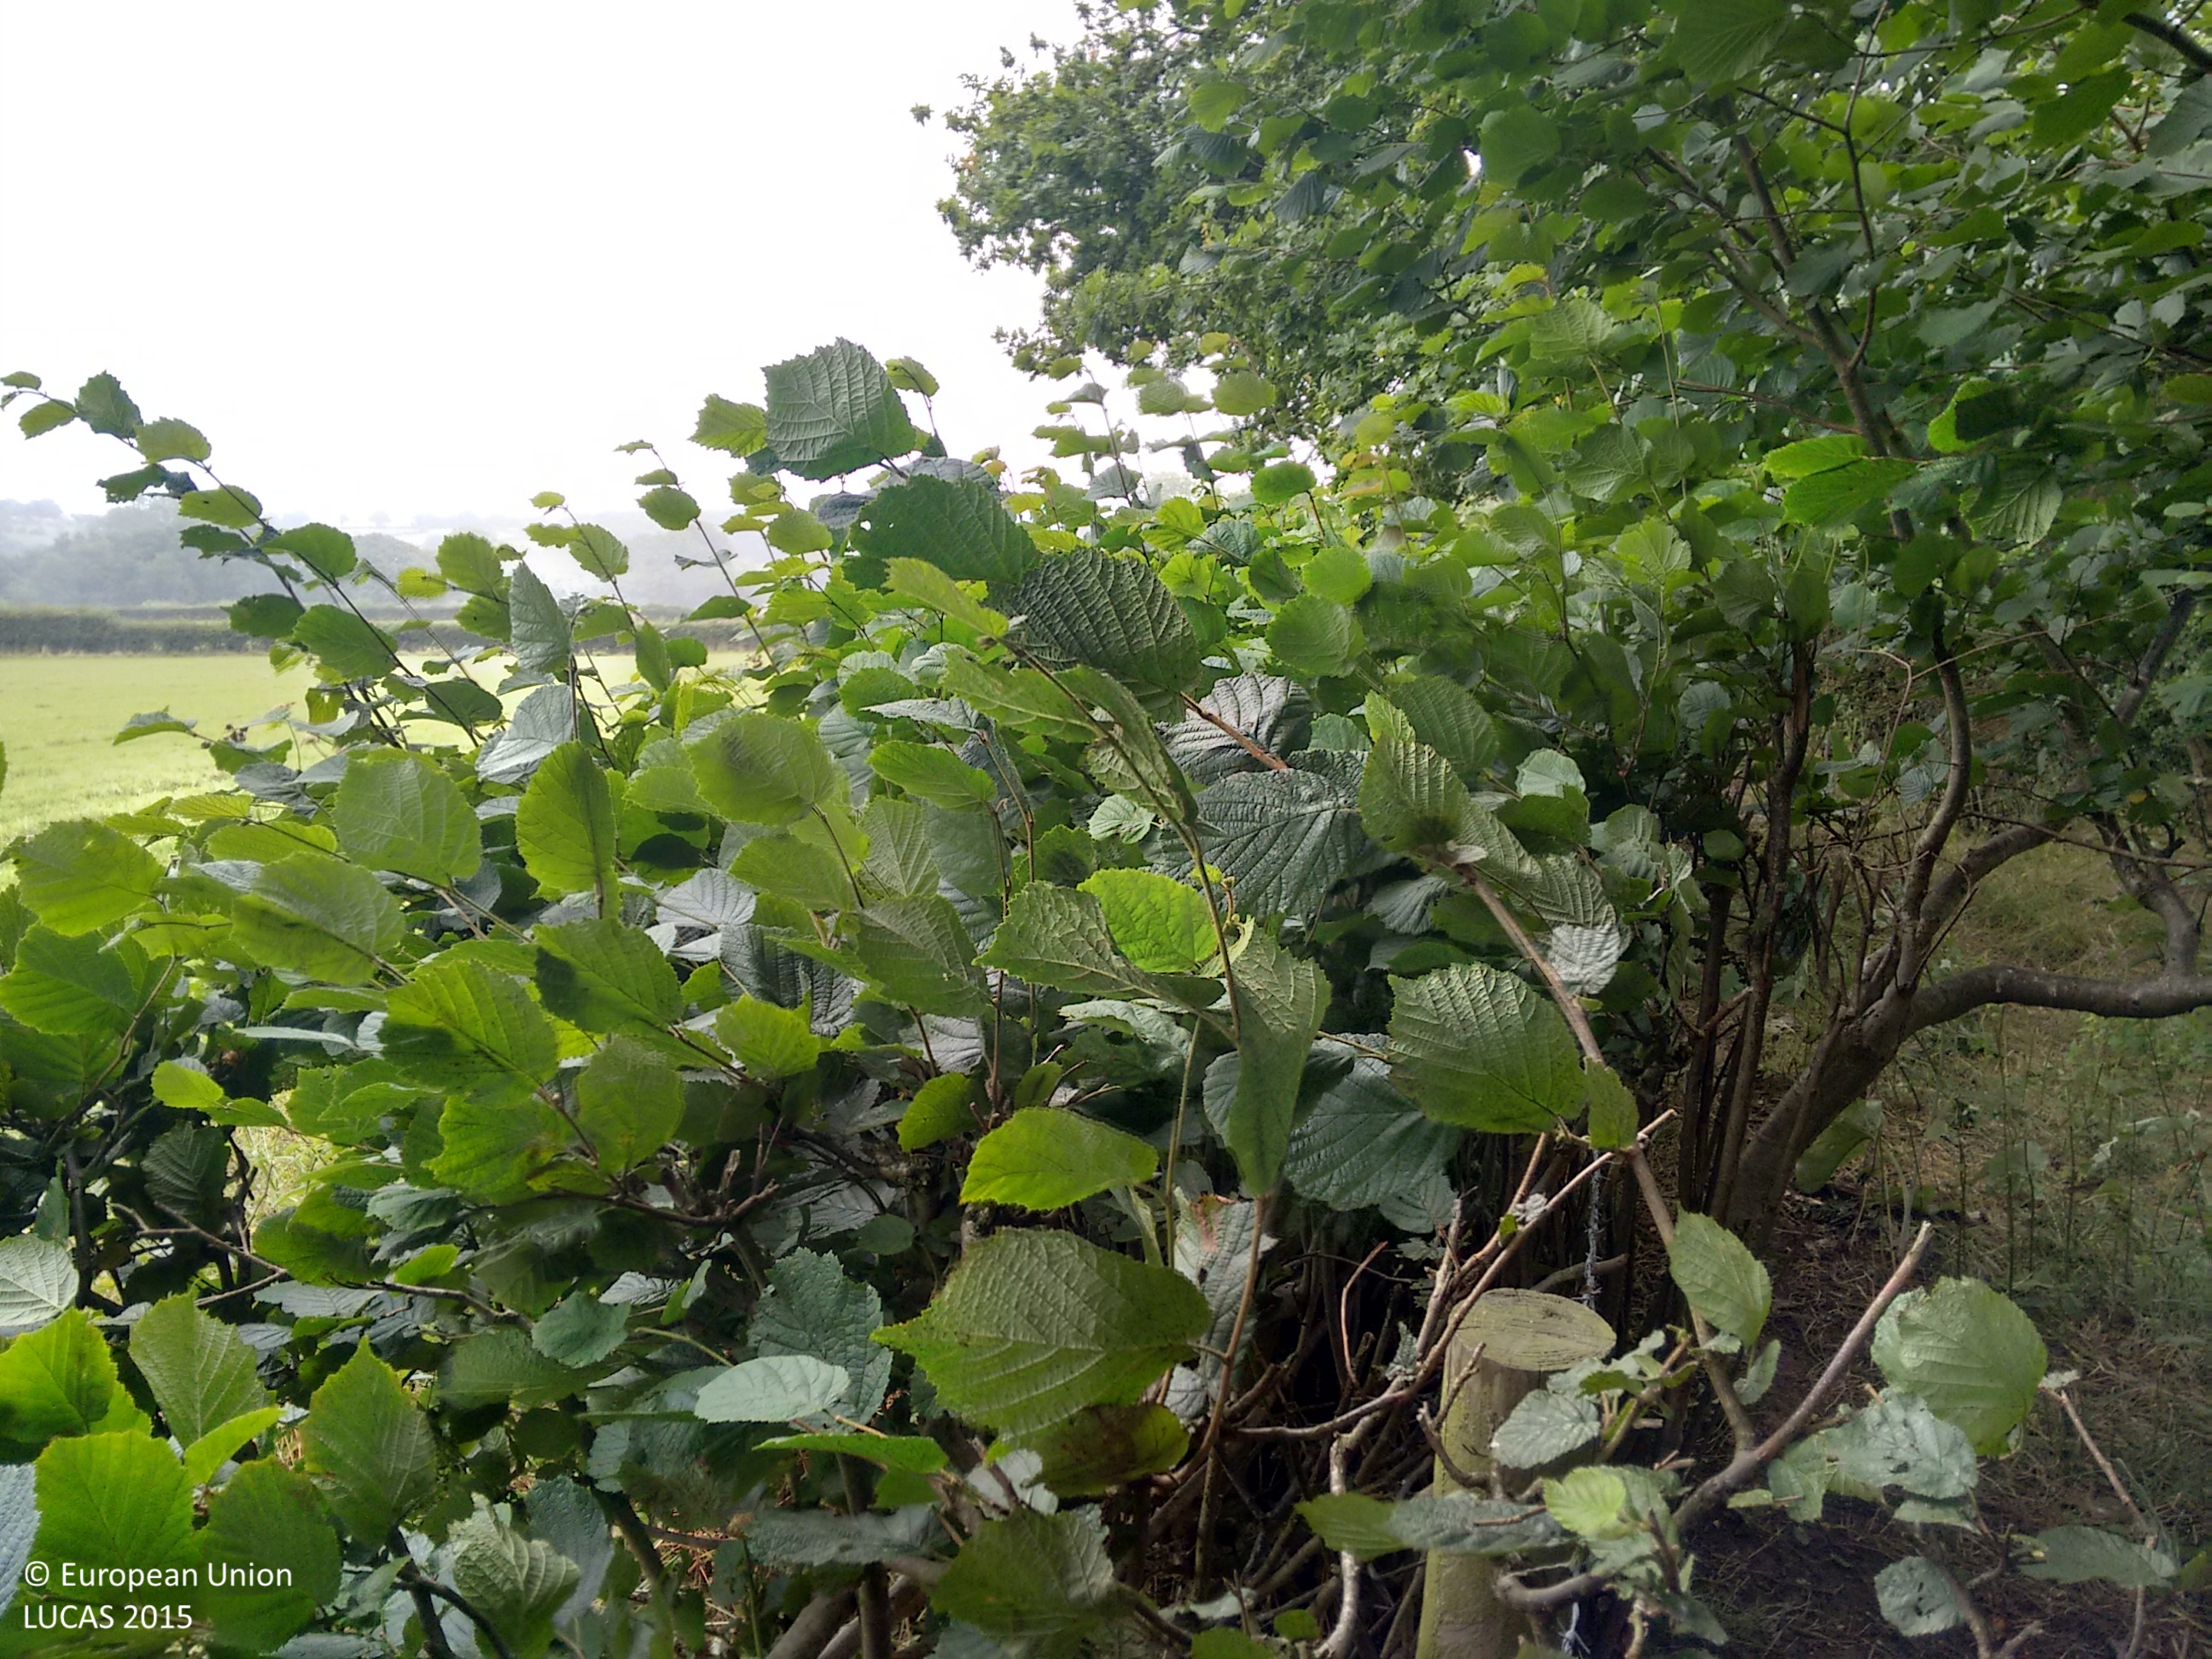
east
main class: Grassland
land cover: Grassland without tree/shrub cover
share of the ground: > 75 %
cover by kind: herbaceous plants 100 %
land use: Agriculture (excluding fallow land and kitchen gardens)
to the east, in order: Managed hedges; Grassland without tree/shrub cover; Fences; Managed hedges; Ditches and canals; Grassland without tree/shrub cover; Fences; Managed hedges; Grassland without tree/shrub cover
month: August
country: GB
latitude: 51.9908
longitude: -2.9626
